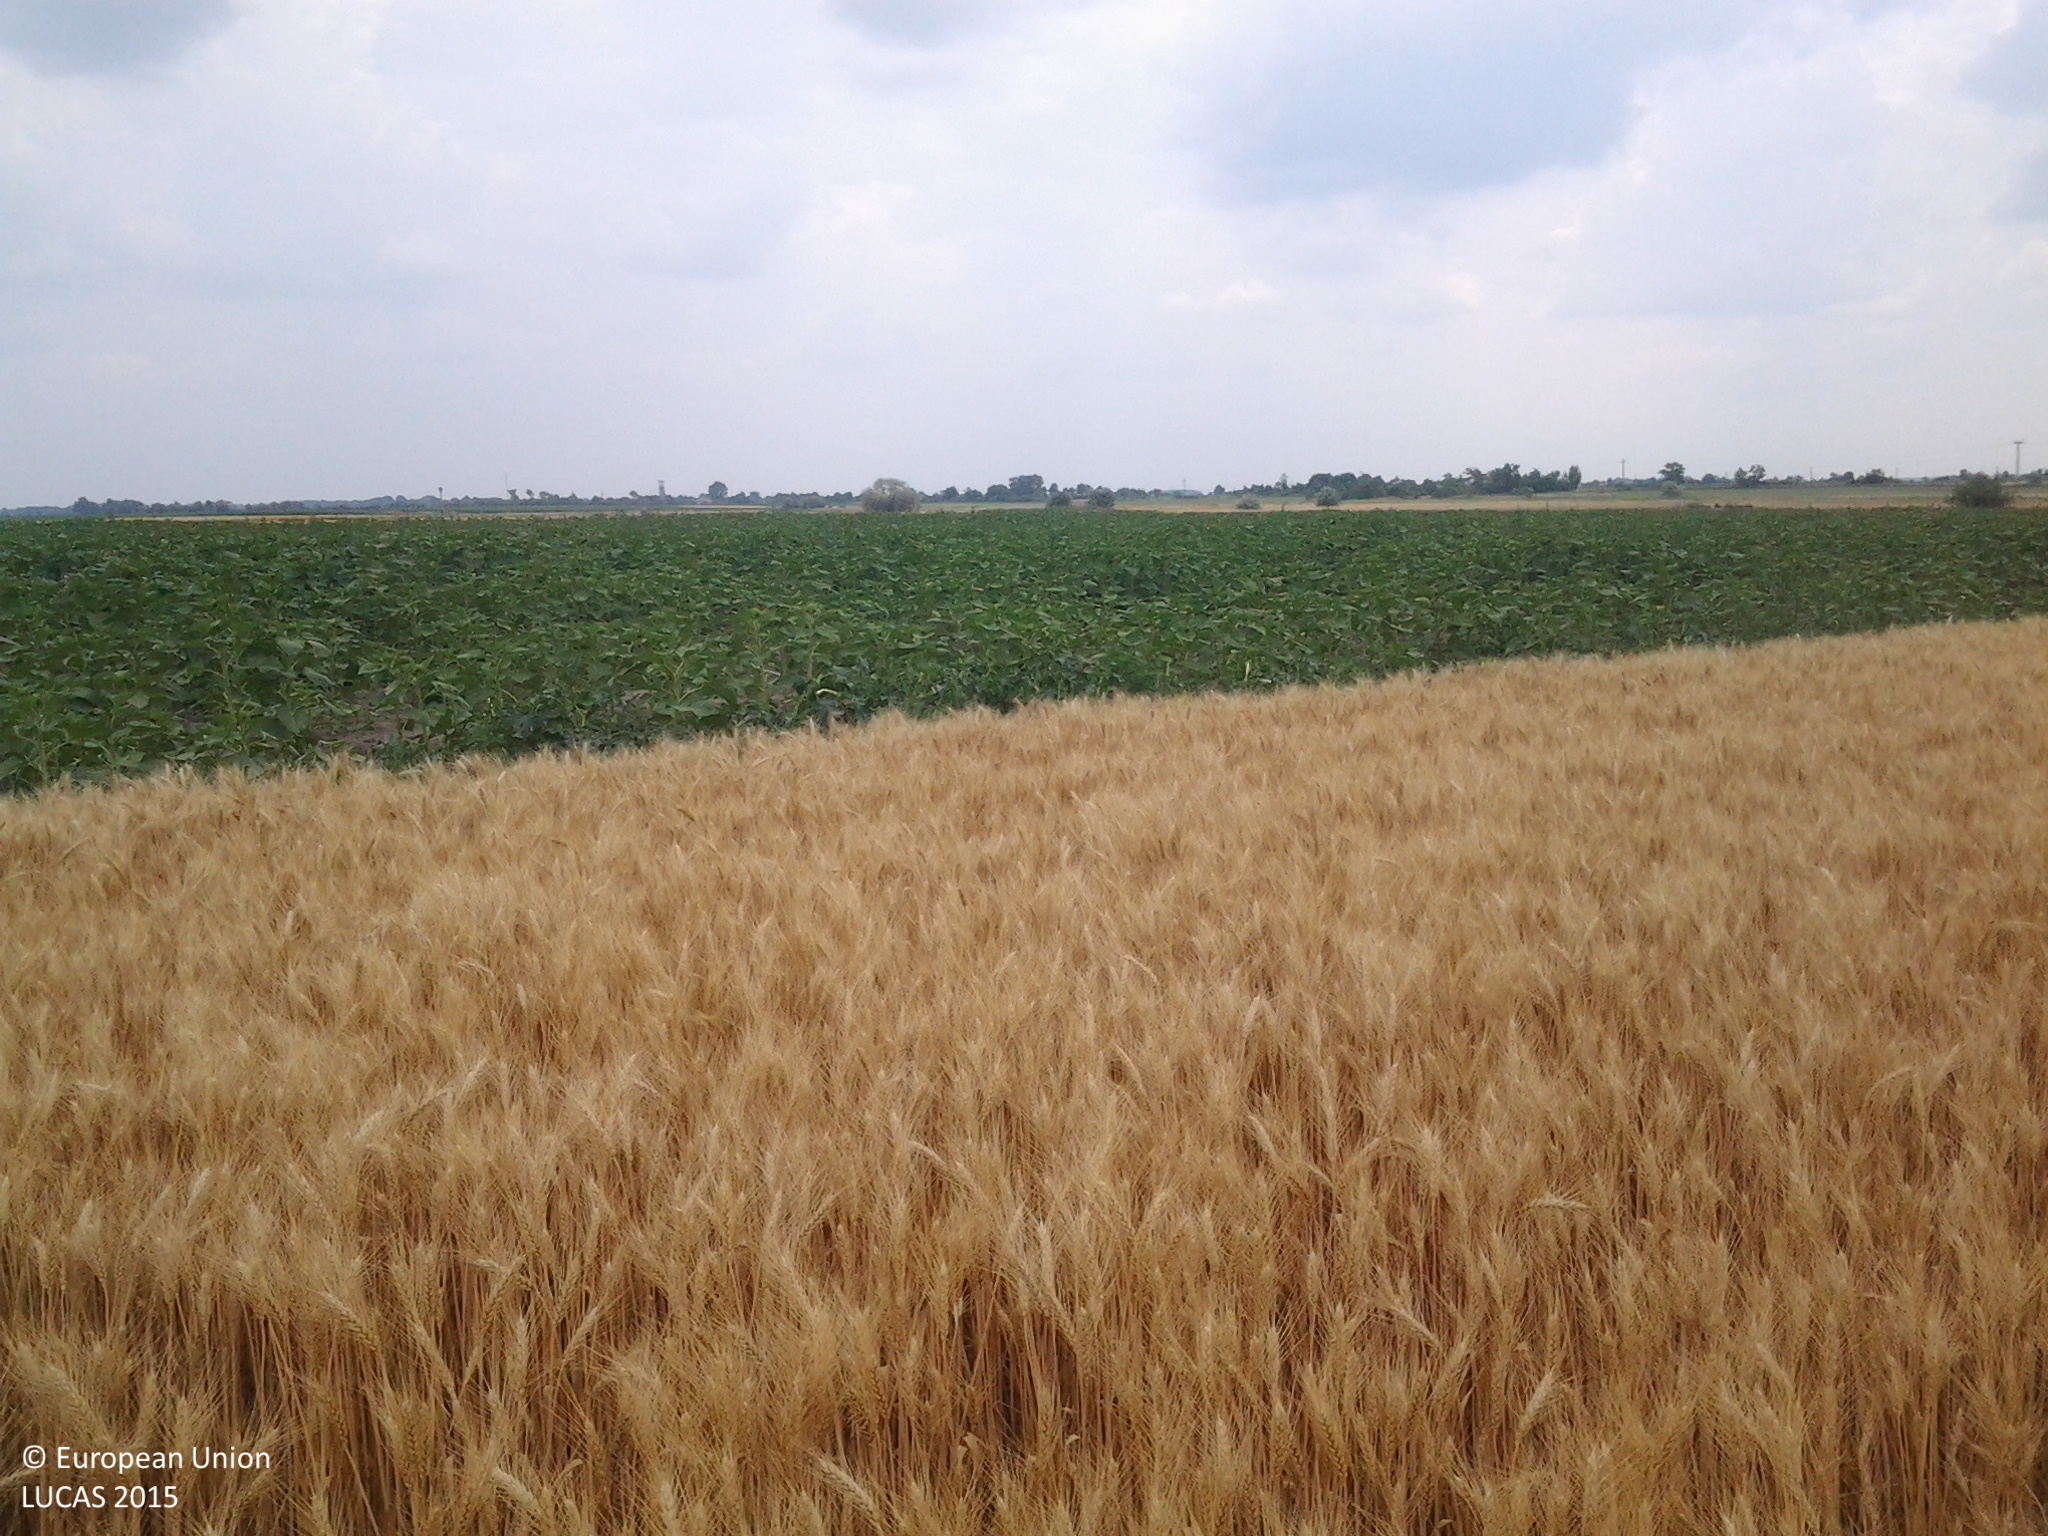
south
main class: Cropland
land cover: Common wheat
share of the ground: > 75 %
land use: Agriculture (excluding fallow land and kitchen gardens)
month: June
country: HU
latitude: 46.8568
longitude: 19.2375
